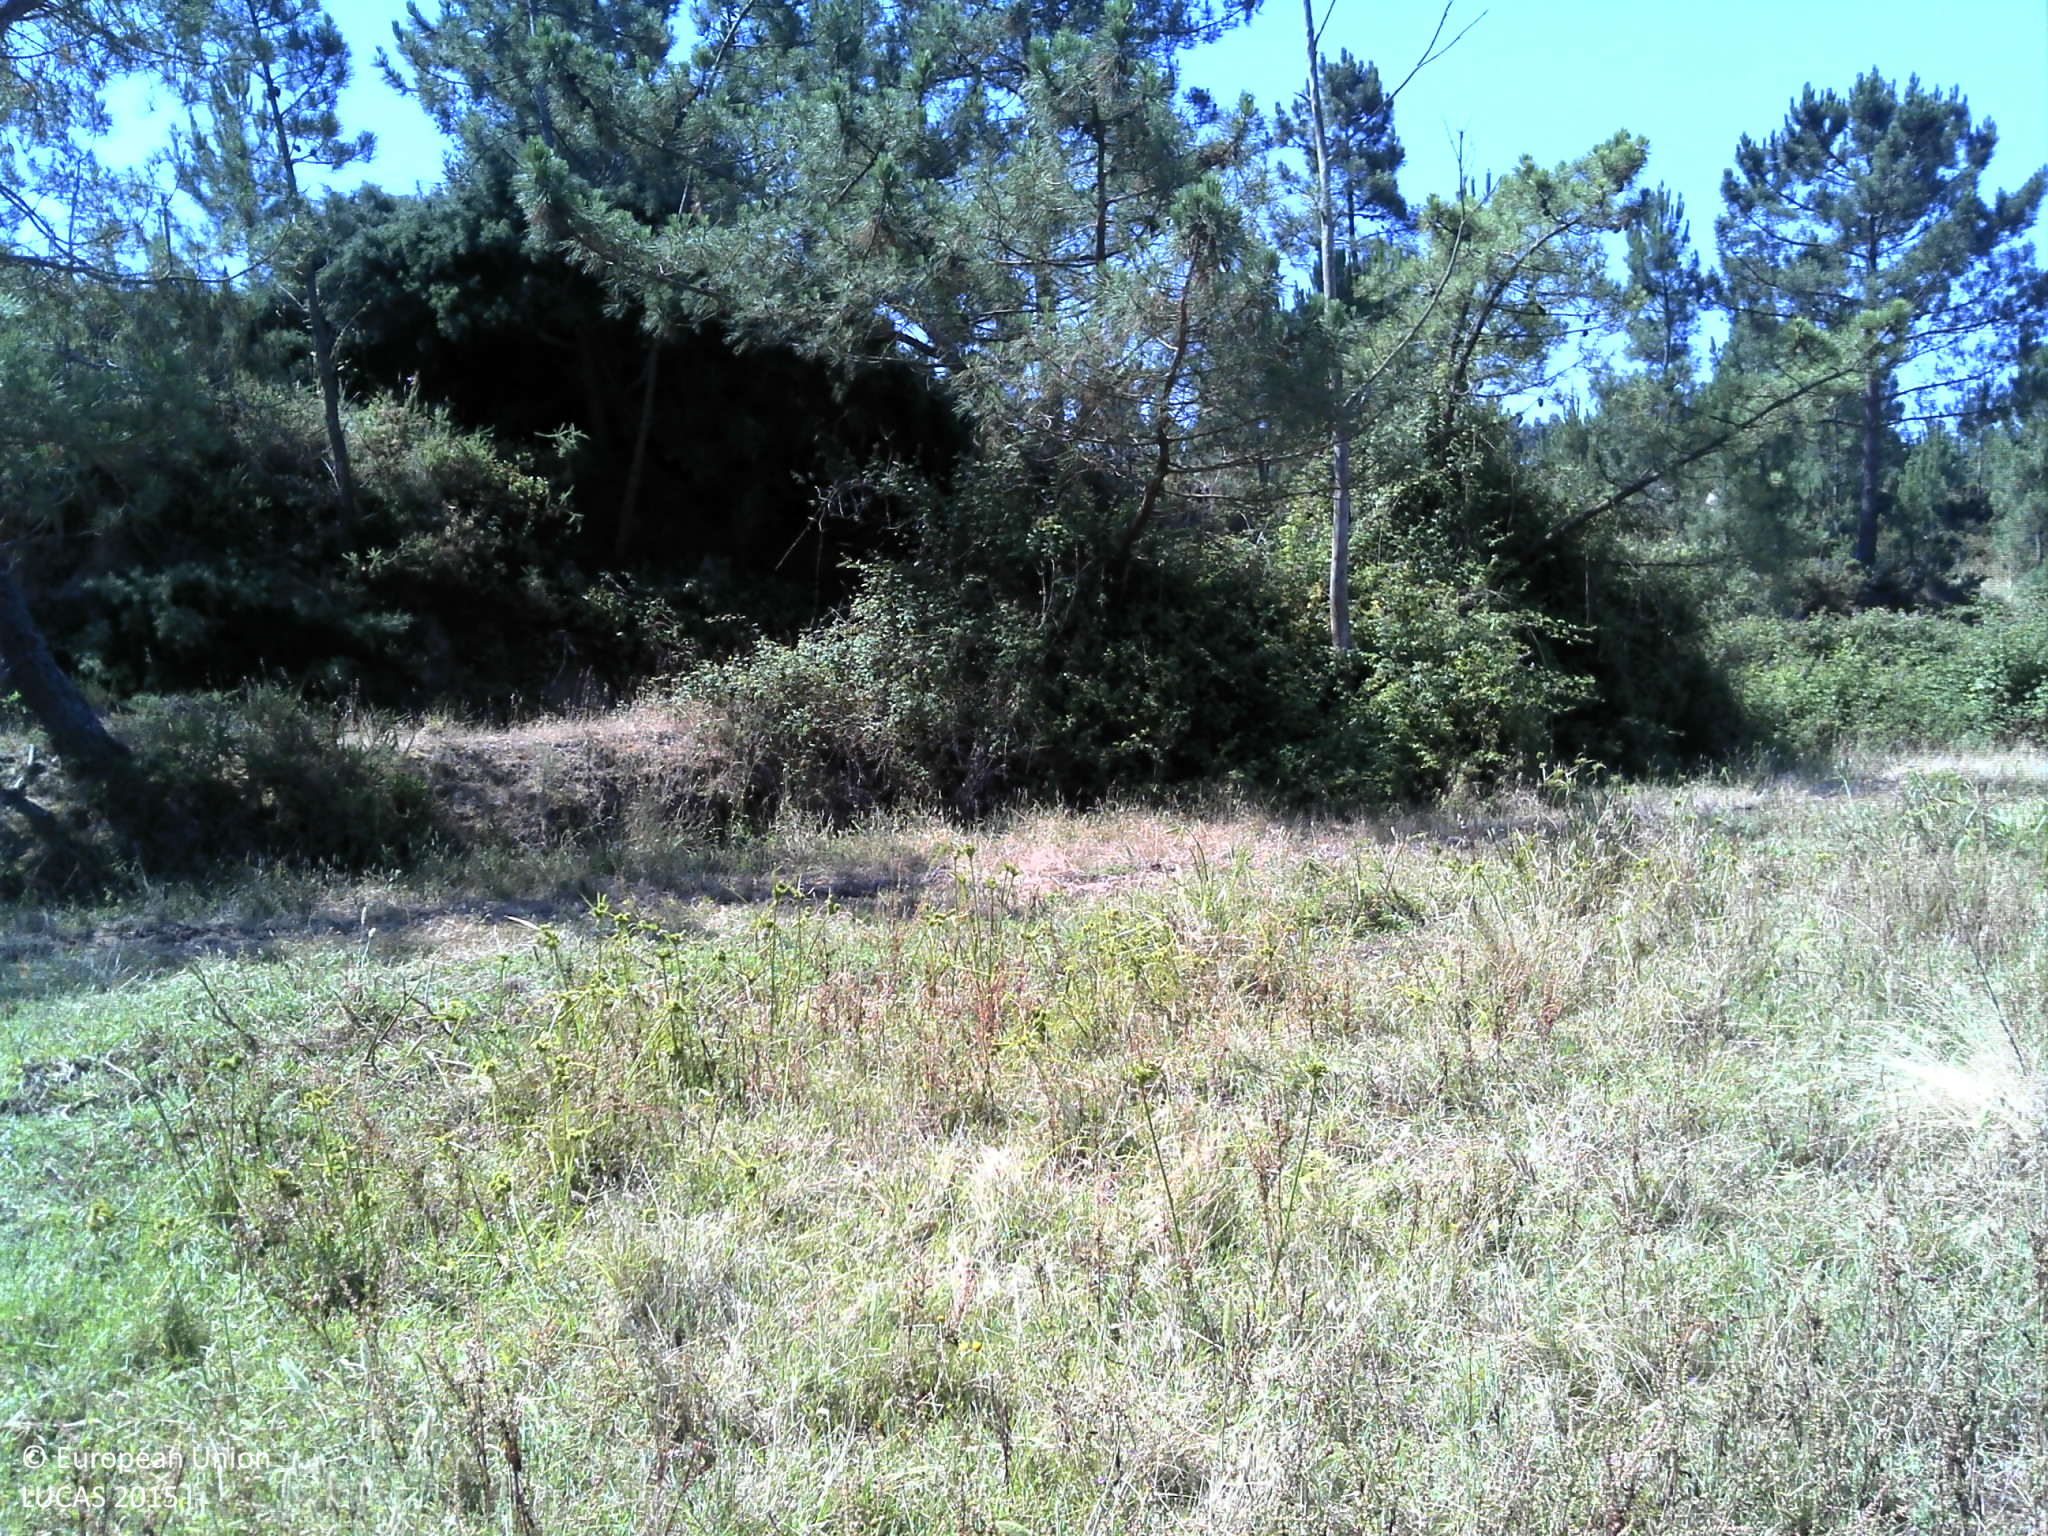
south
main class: Grassland
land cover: Grassland without tree/shrub cover
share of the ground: 50 - 75 %
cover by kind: herbaceous plants 55 %, unconsolidated bare surface 40 %, shrubs 5 %
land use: Agriculture (excluding fallow land and kitchen gardens)
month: June
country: PT
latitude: 39.1097
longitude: -9.2965
